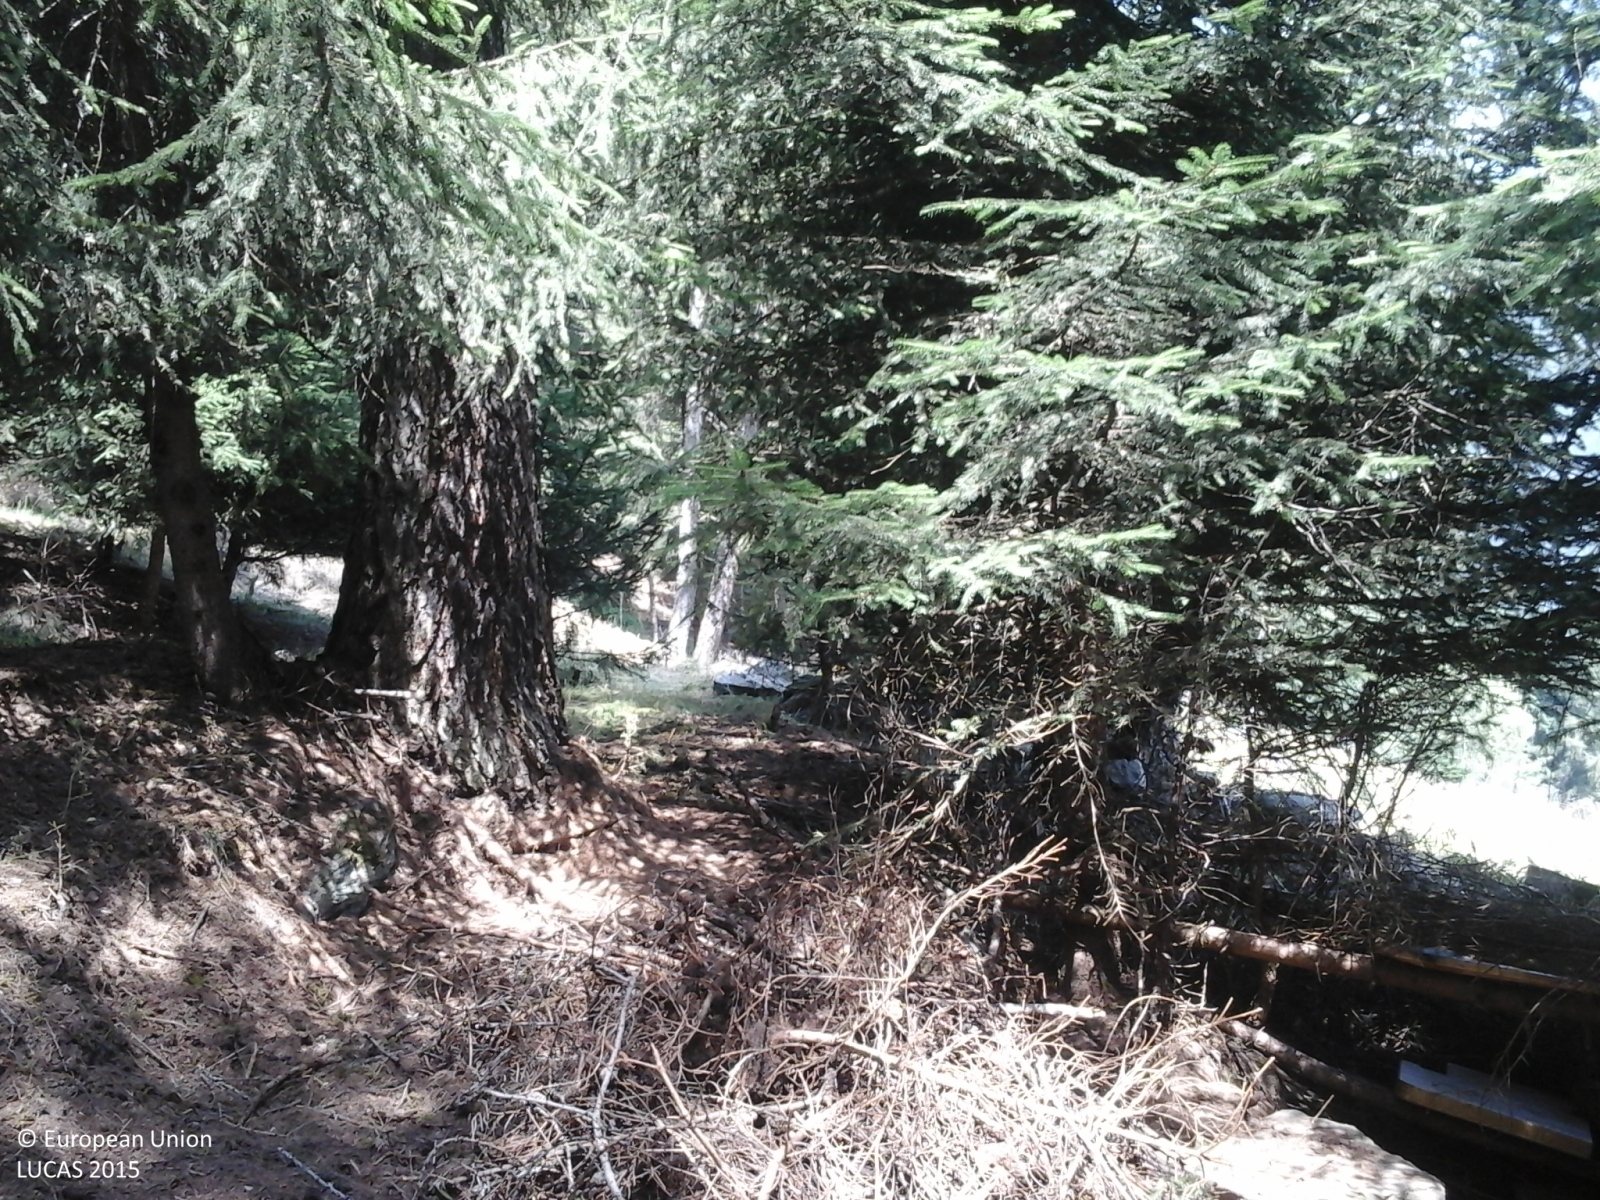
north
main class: Woodland
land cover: Spruce dominated coniferous woodland
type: alpine coniferous forest
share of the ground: > 75 %
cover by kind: coniferous forest trees 100 %
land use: Agriculture (excluding fallow land and kitchen gardens)
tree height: > 5 m
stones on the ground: < 10 %
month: July
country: IT
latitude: 46.1891
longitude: 10.0647
